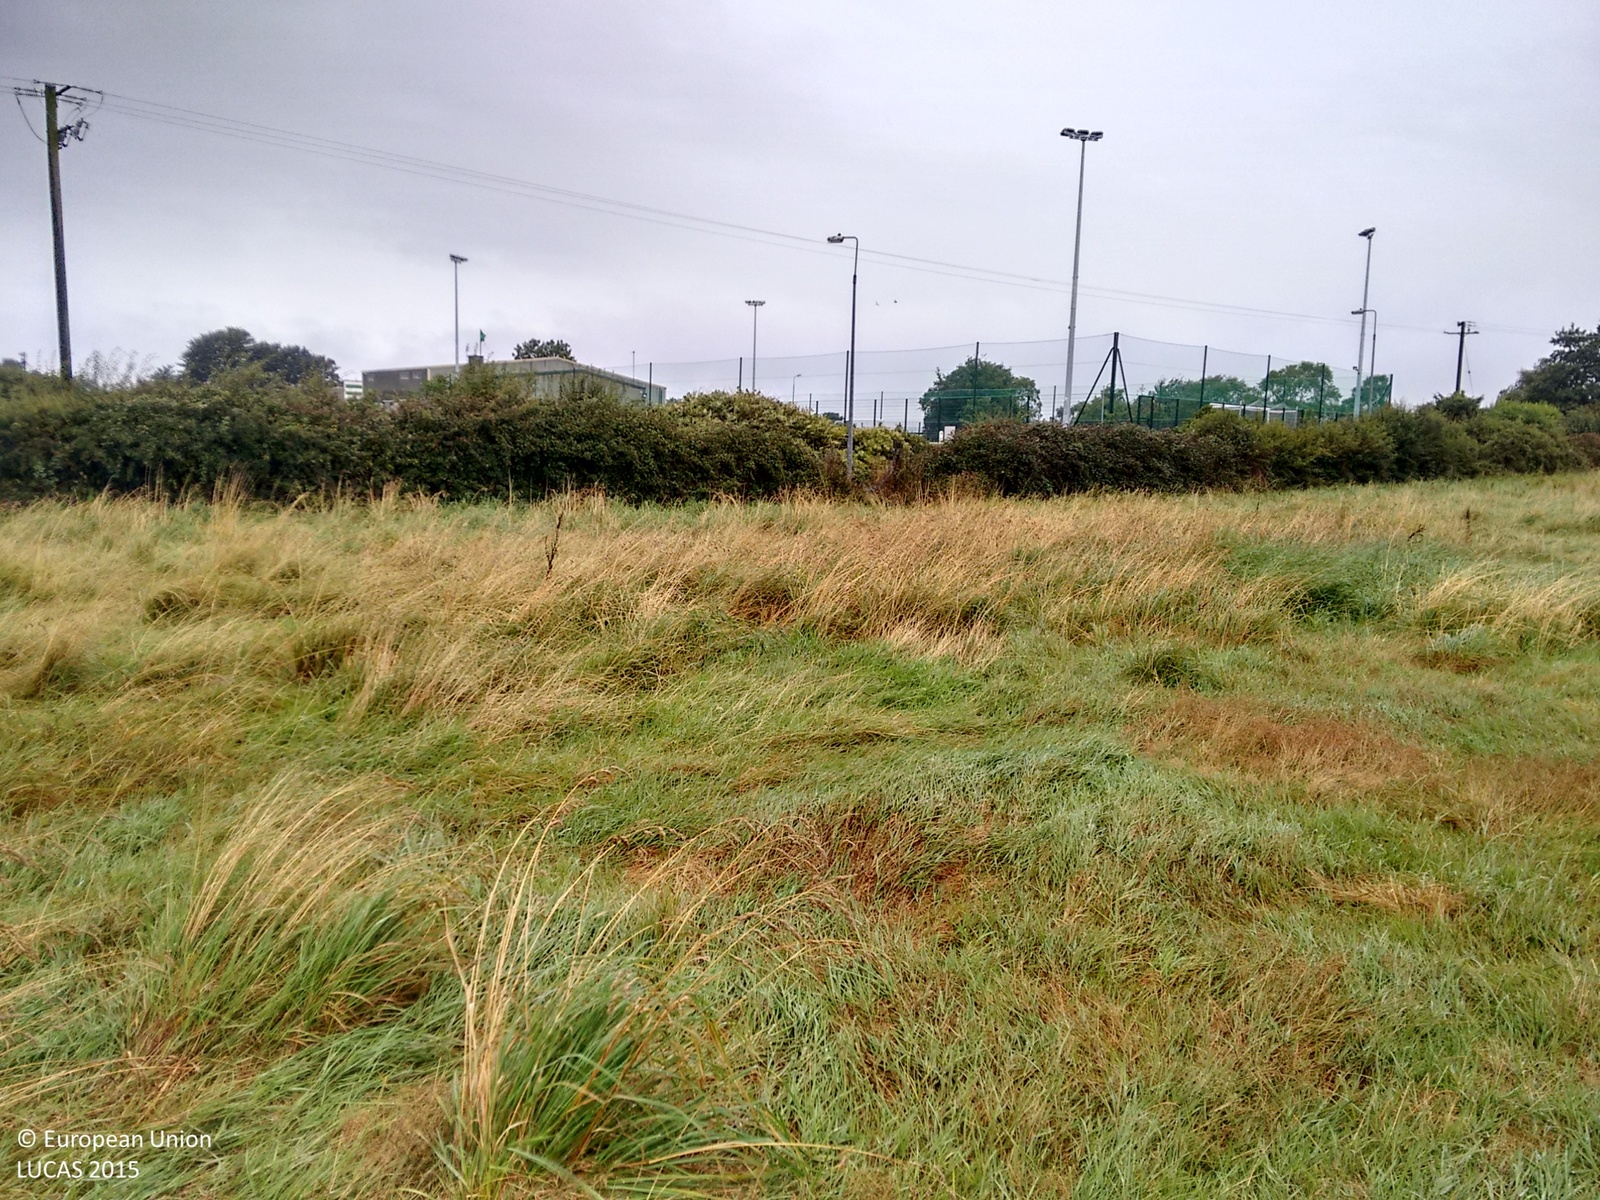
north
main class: Grassland
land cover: Grassland without tree/shrub cover
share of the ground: > 75 %
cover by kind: herbaceous plants 100 %
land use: Sport
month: September
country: IE
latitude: 52.6442
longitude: -8.5978
